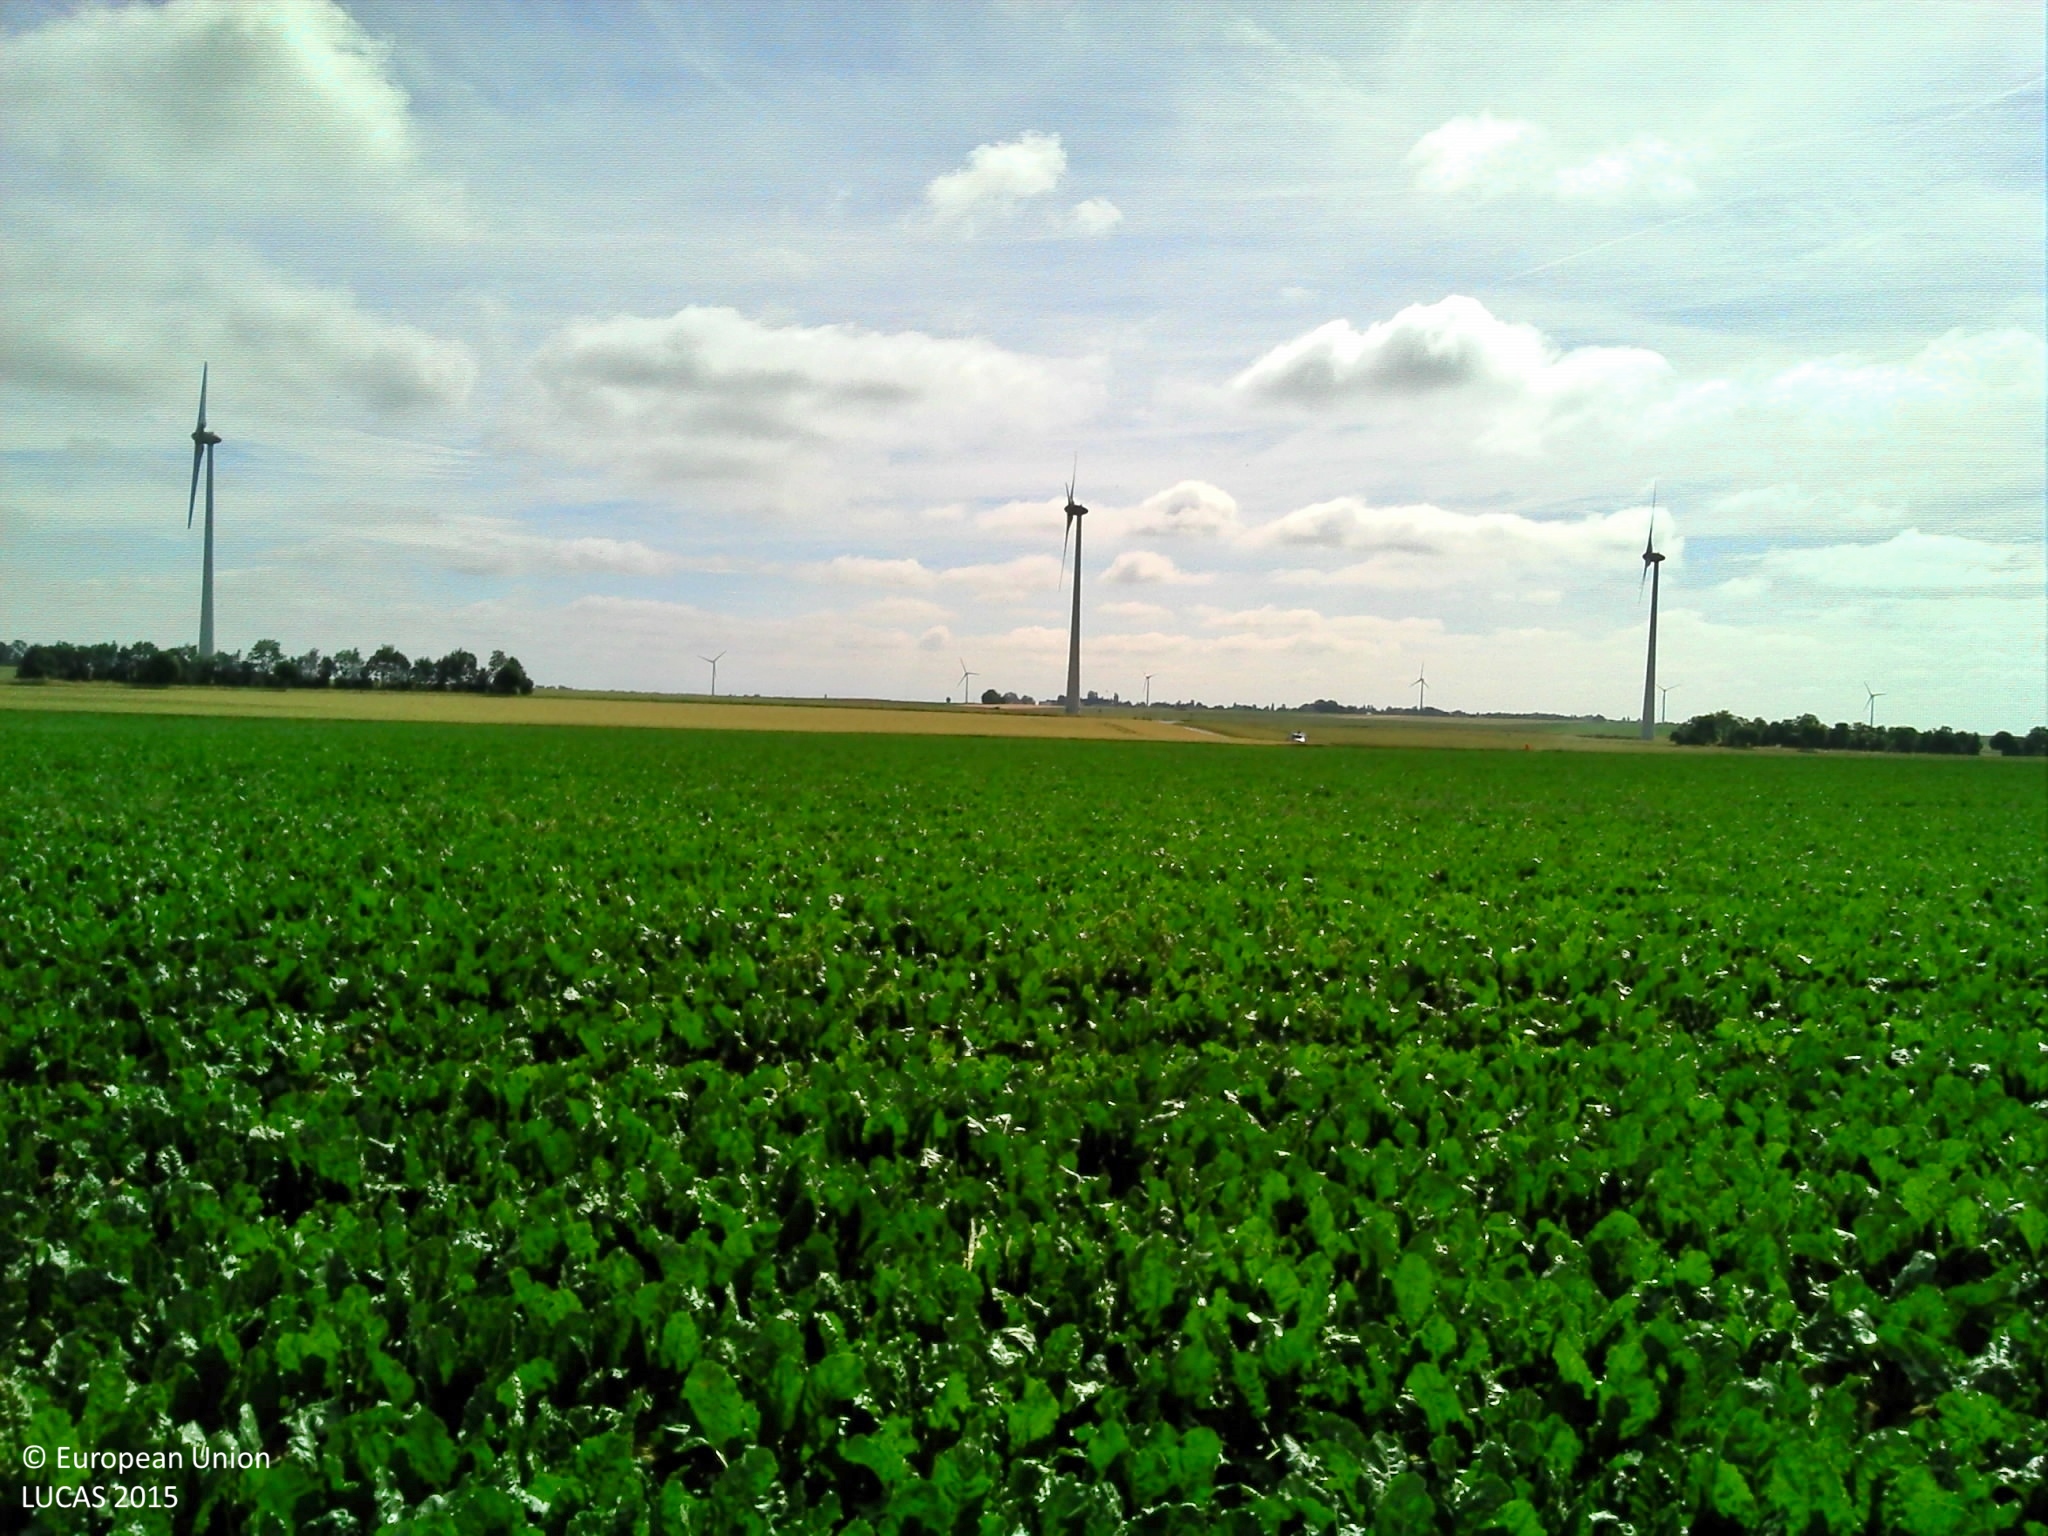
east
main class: Cropland
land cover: Sugar beet
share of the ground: > 75 %
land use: Agriculture (excluding fallow land and kitchen gardens)
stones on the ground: < 10 %
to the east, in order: Sugar beet
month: June
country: FR
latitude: 49.5651
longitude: 2.3410
